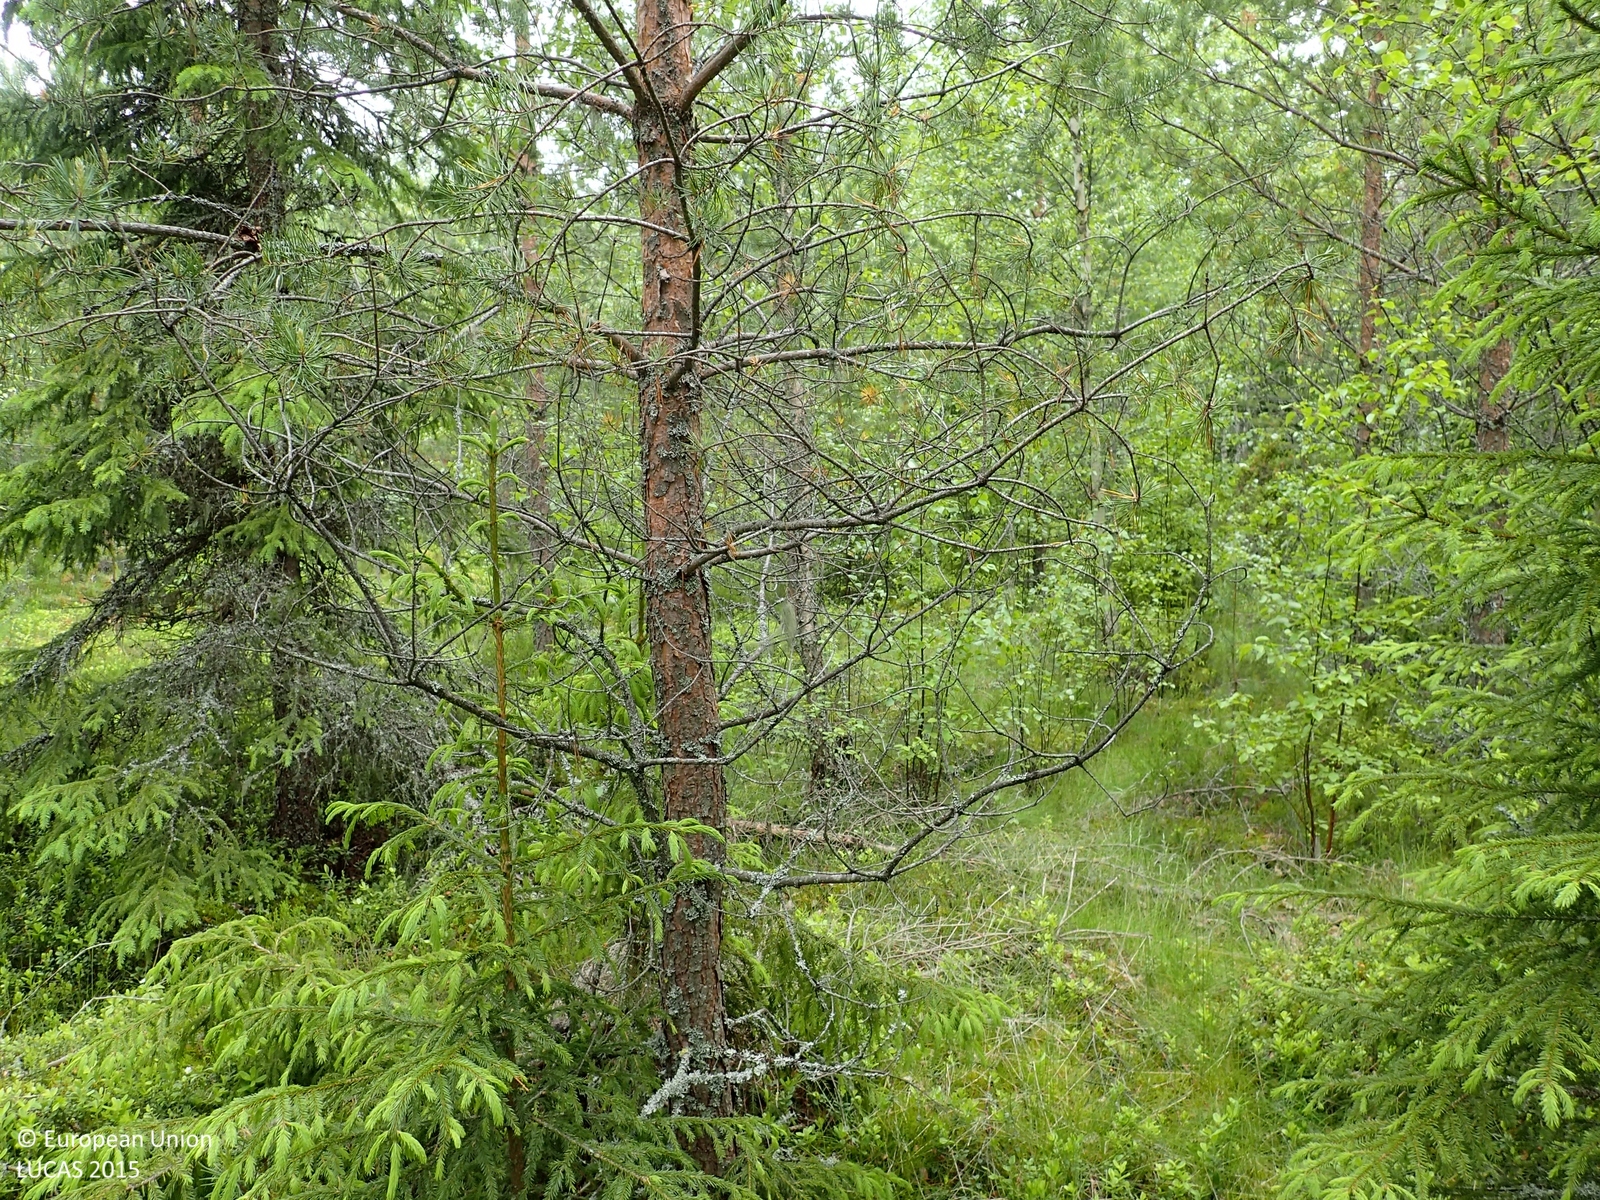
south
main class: Woodland
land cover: Pine dominated coniferous woodland
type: boreal forest
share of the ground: > 75 %
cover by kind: coniferous forest trees 70 %, shrubs 25 %, broadleaved forest trees 5 %
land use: Forestry
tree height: > 5 m
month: June
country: FI
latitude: 62.3528
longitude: 21.7342
